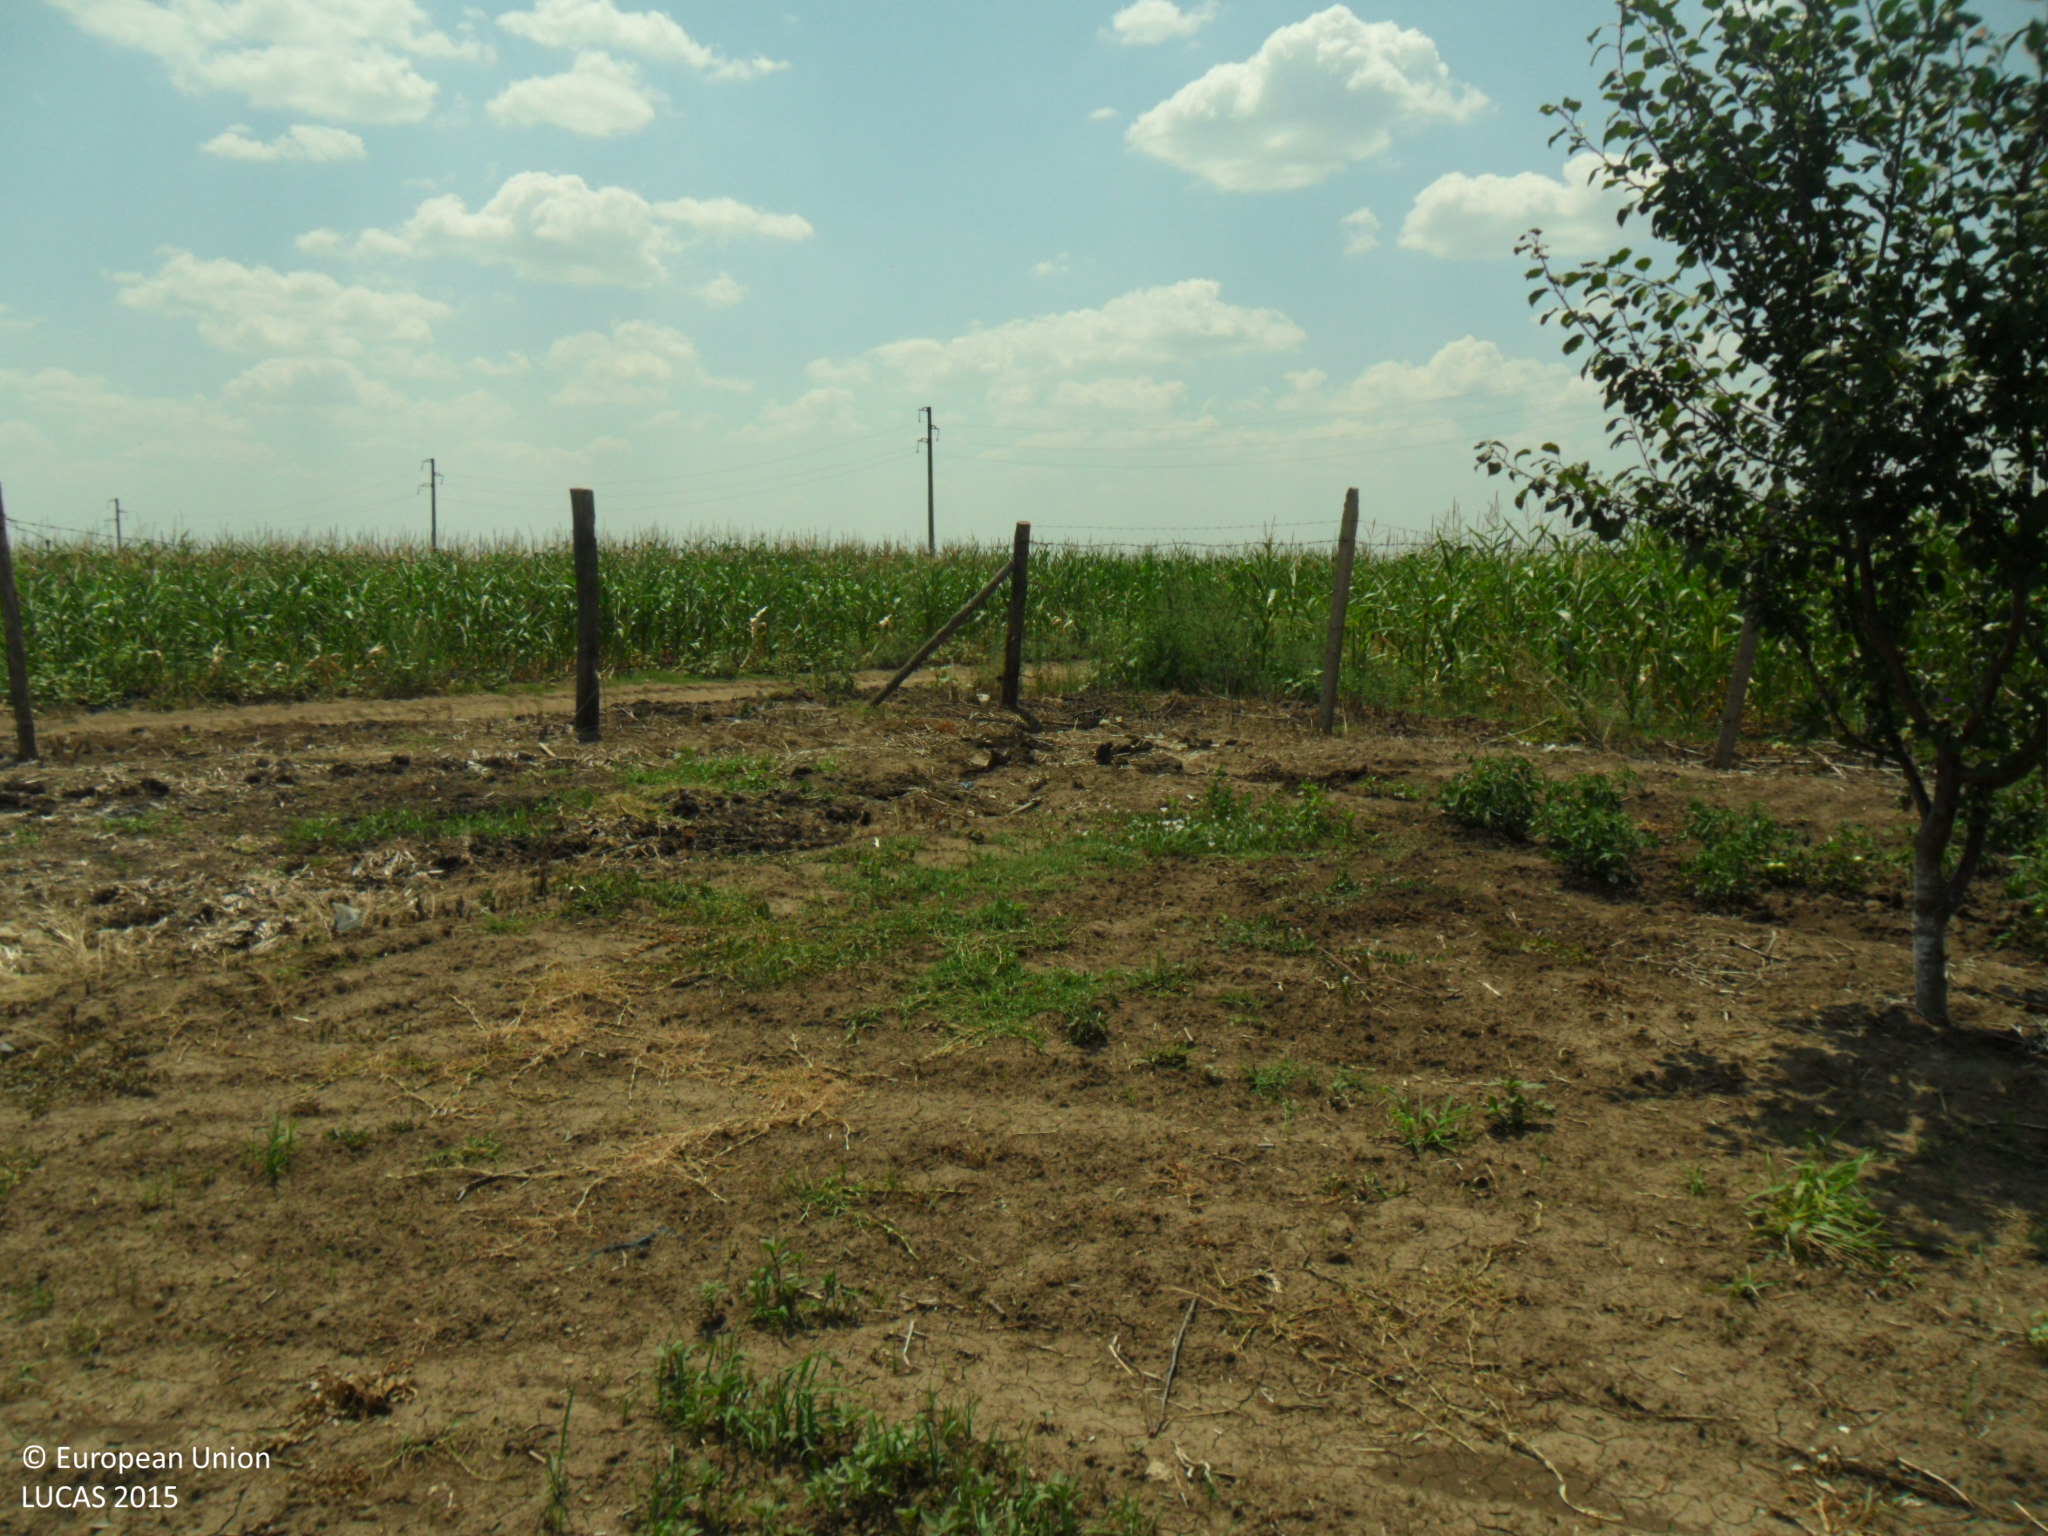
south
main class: Cropland
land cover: Other fruit trees and berries
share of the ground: 50 - 75 %
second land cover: Spontaneously vegetated surfaces
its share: 10 - 25 %
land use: Agriculture (excluding fallow land and kitchen gardens)
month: July
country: BG
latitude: 43.6356
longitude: 27.3199
